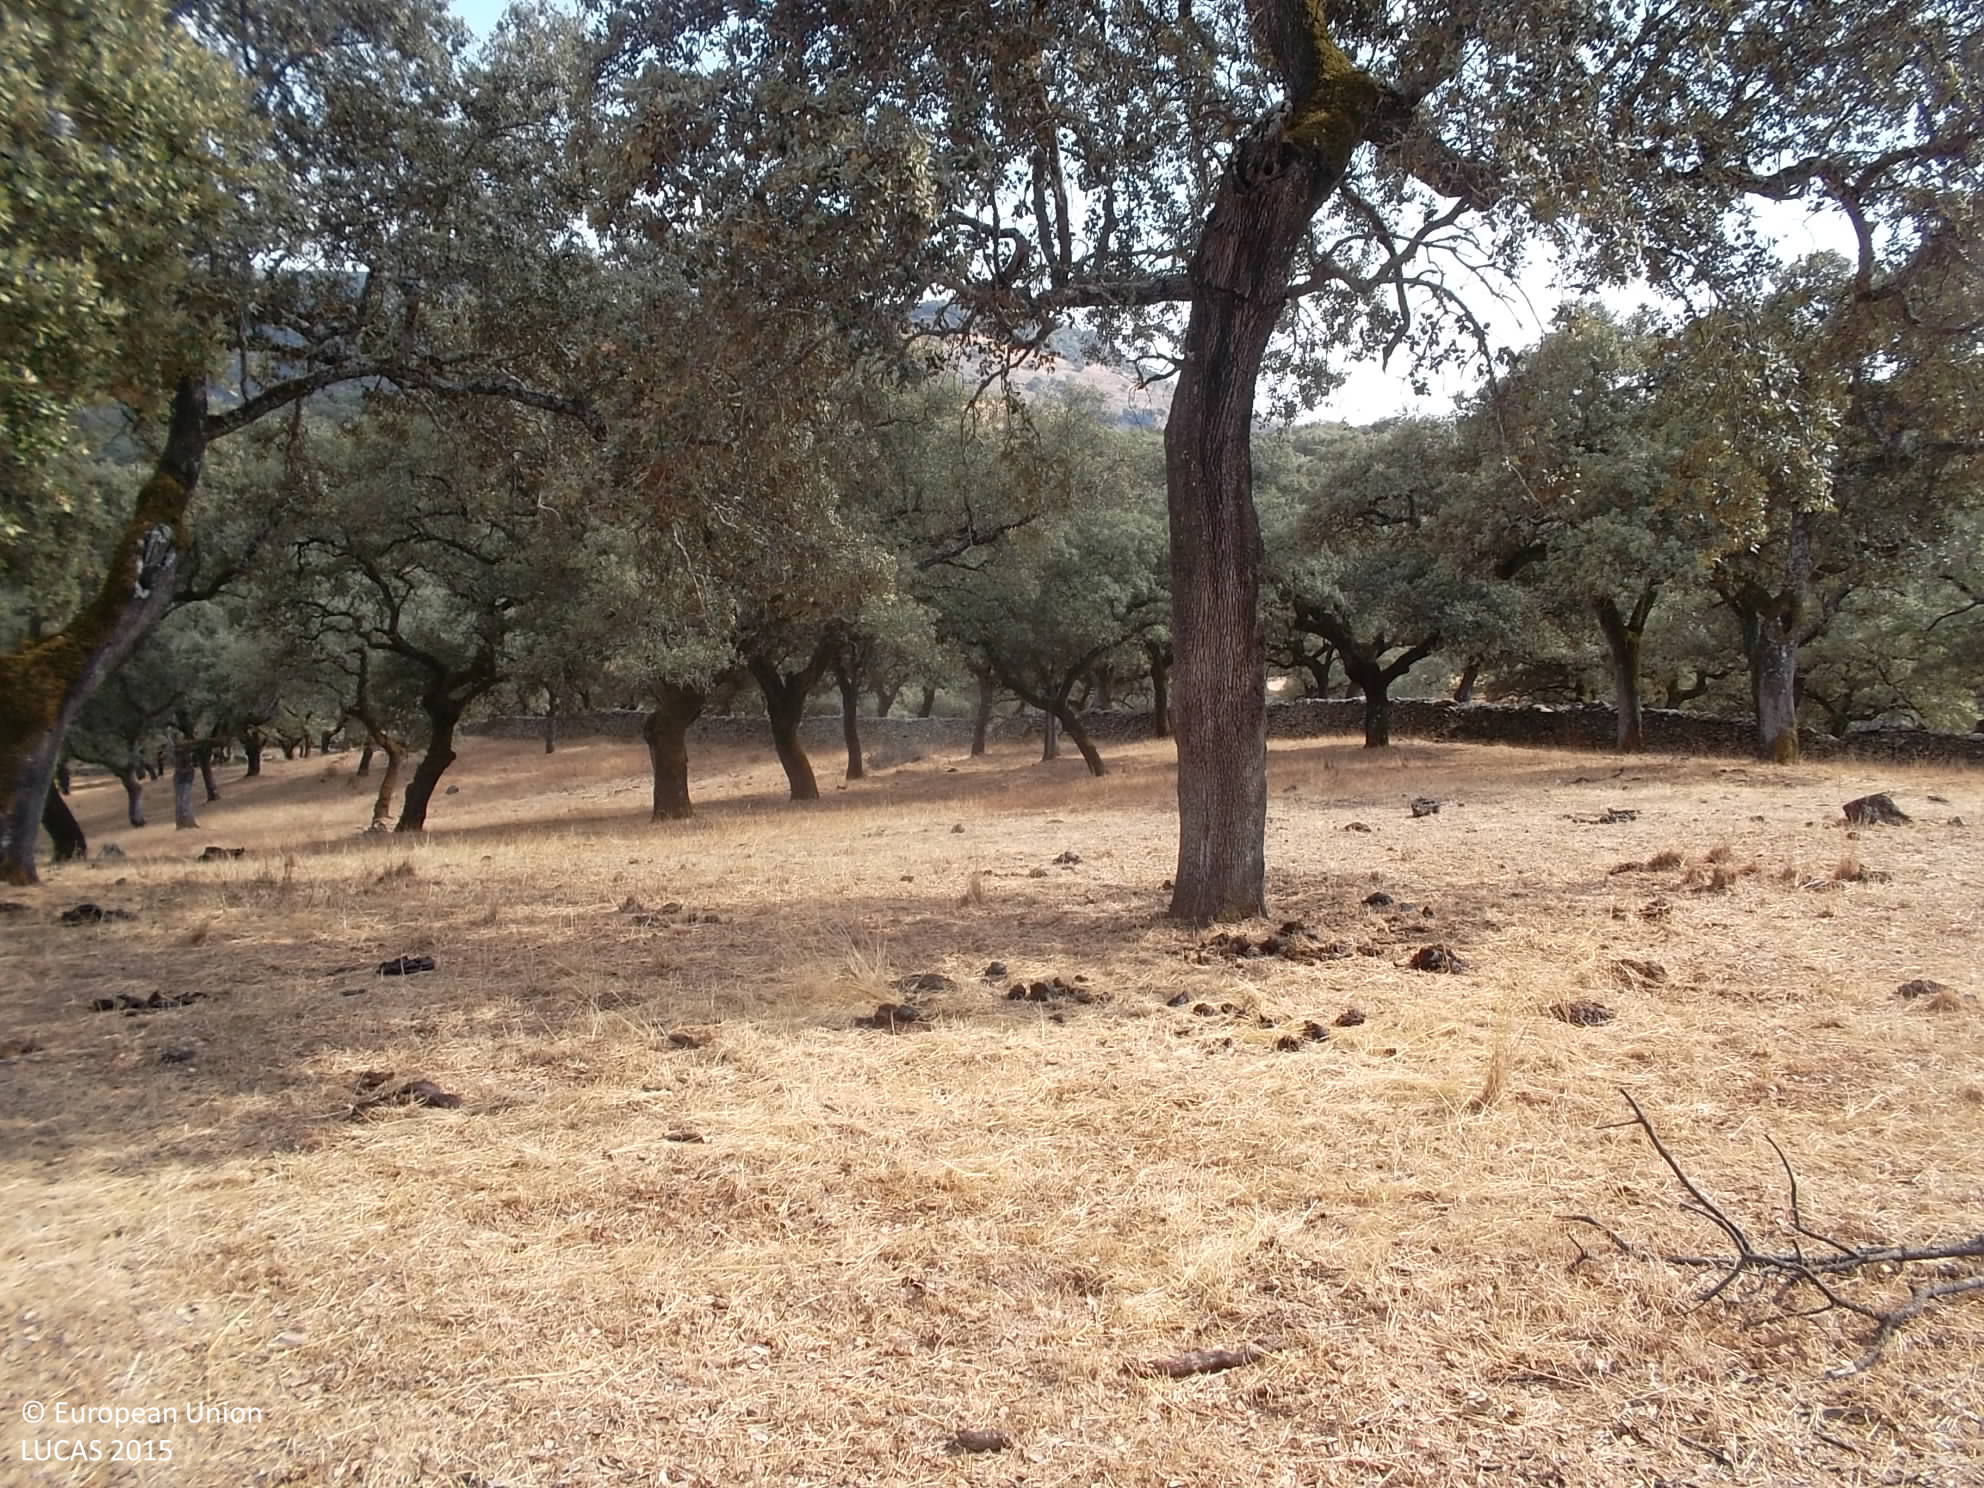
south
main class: Woodland
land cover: Broadleaved woodland
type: broadleaved evergreen forest
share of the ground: 50 - 75 %
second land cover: Grassland without tree/shrub cover
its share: > 75 %
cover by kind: broadleaved forest trees 50 %, herbaceous plants 50 %
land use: Forestry
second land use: Agriculture (excluding fallow land and kitchen gardens)
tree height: > 5 m
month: September
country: ES
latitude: 38.0503
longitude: -6.4890
